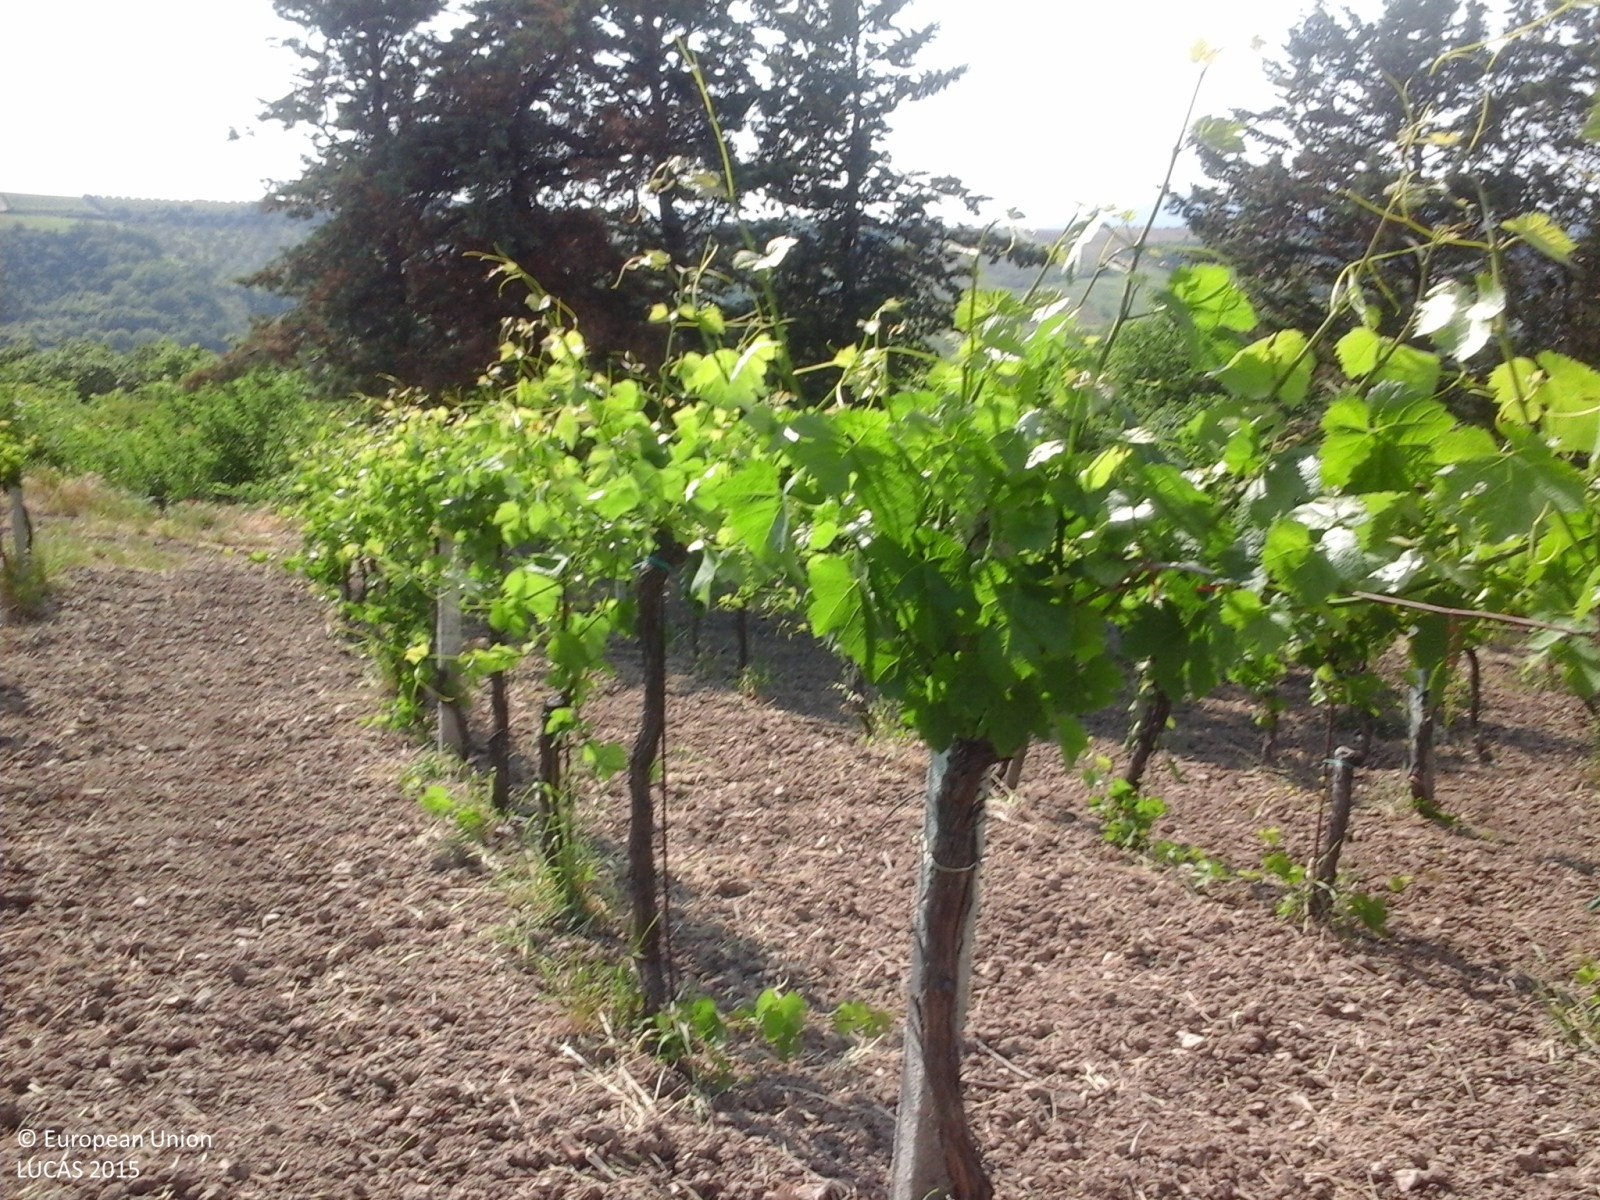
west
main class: Cropland
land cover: Vineyards
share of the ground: 50 - 75 %
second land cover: Other bare soil
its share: > 75 %
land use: Agriculture (excluding fallow land and kitchen gardens)
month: May
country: IT
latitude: 41.2240
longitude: 14.6944
